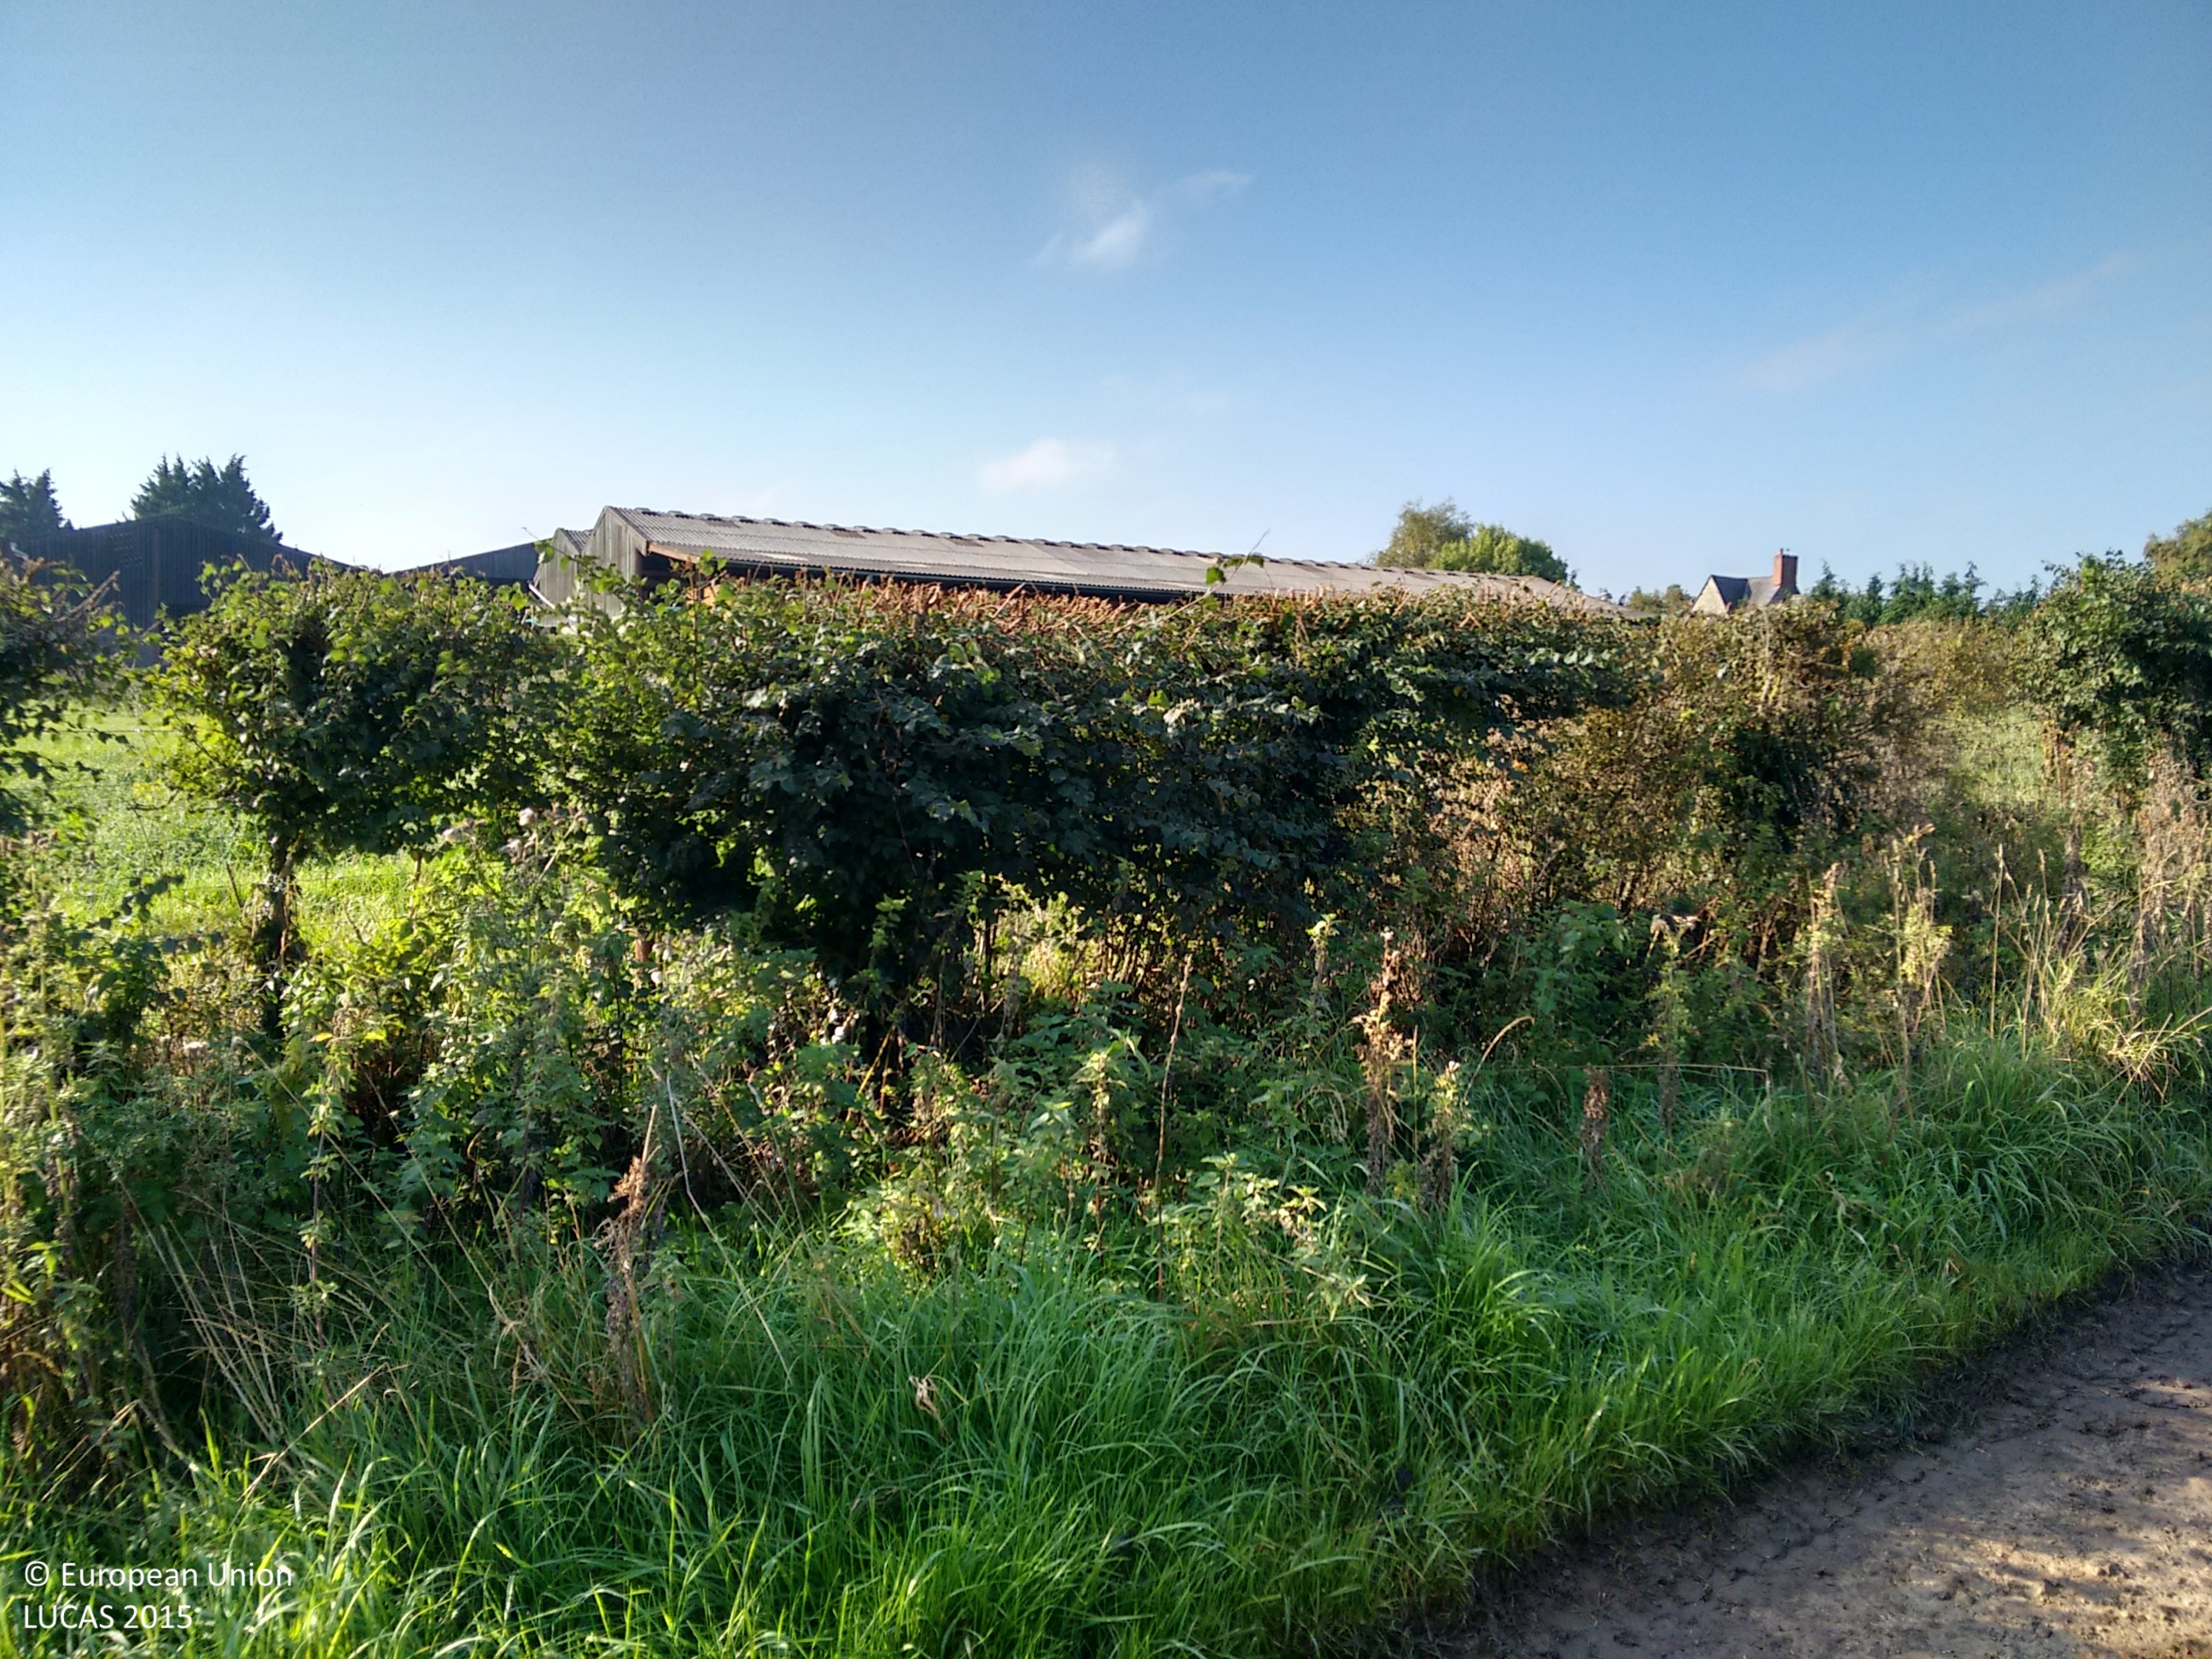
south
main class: Grassland
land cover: Grassland without tree/shrub cover
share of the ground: > 75 %
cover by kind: herbaceous plants 100 %
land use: Agriculture (excluding fallow land and kitchen gardens)
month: September
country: GB
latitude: 51.7758
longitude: -2.4281
